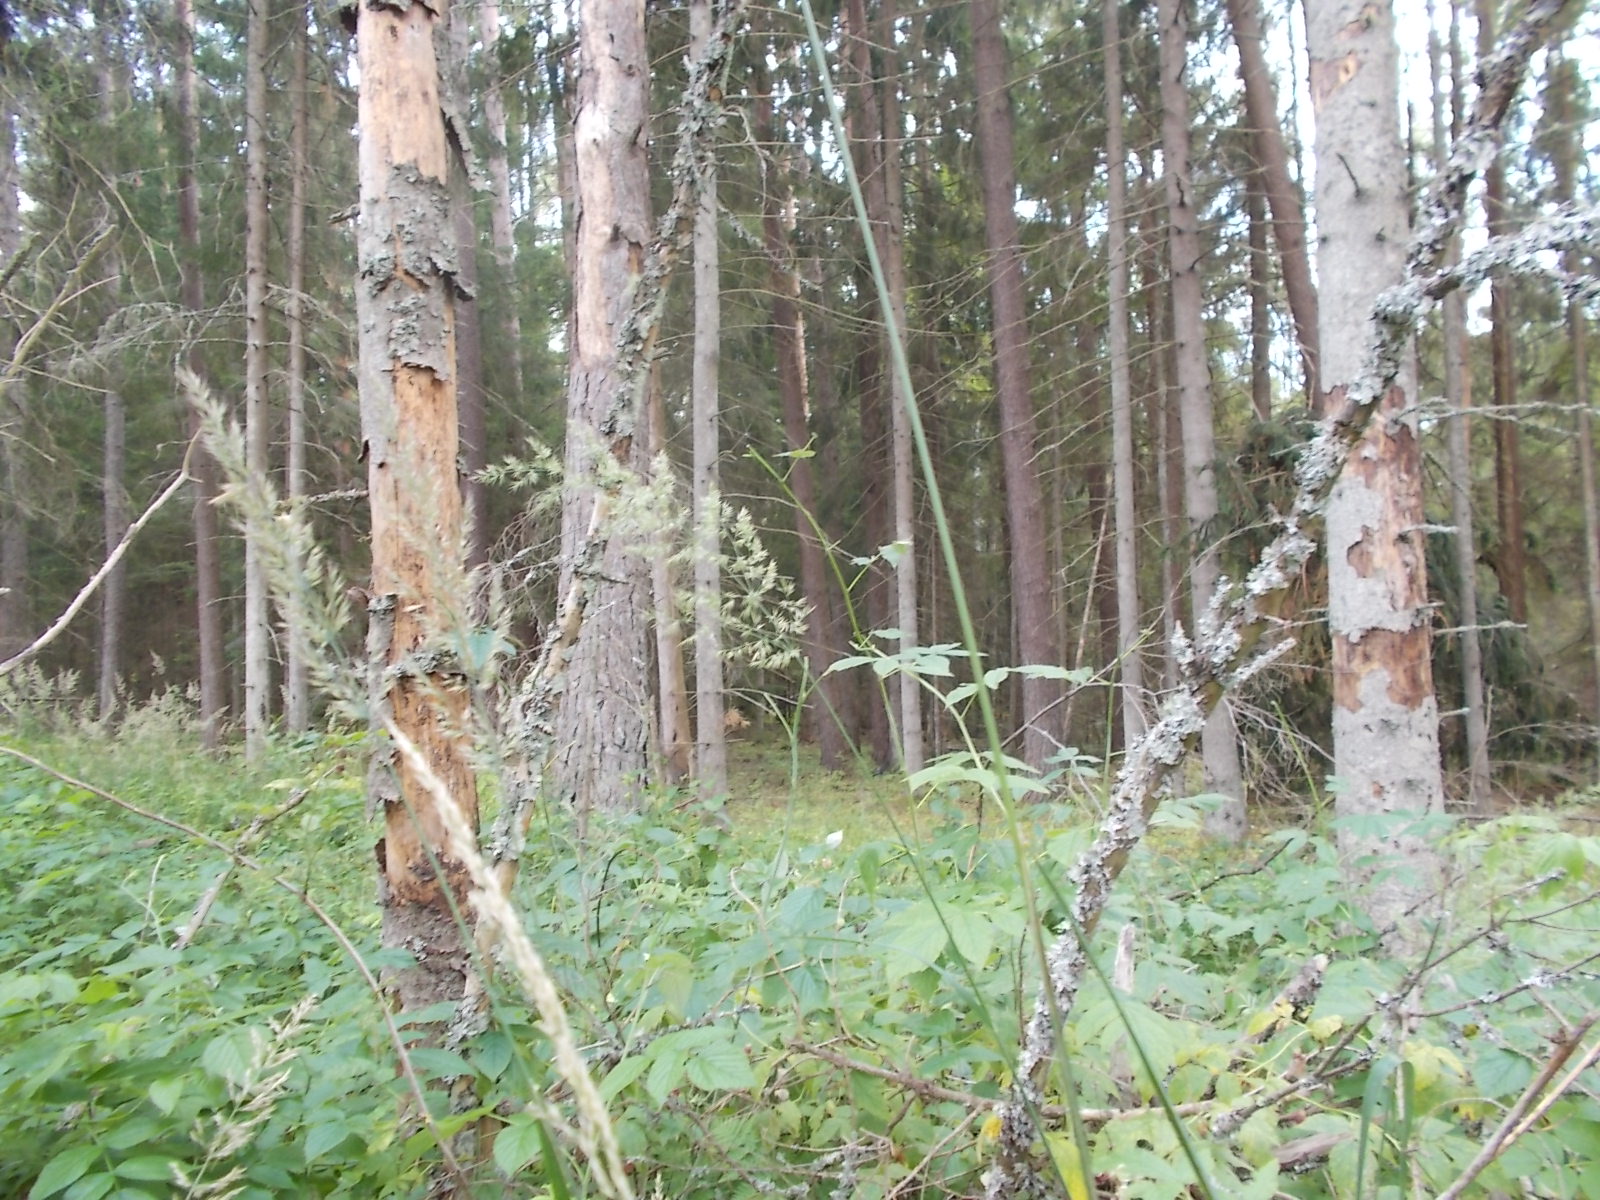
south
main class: Woodland
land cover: Other coniferous woodland
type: hemiboreal forest and nemoral coniferous forest and mixed broadleaved-coniferous forest
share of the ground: 50 - 75 %
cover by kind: coniferous forest trees 60 %, herbaceous plants 20 %, shrubs 15 %, broadleaved forest trees 5 %
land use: Forestry
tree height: > 5 m
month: August
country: LV
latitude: 57.0750
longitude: 21.8392
